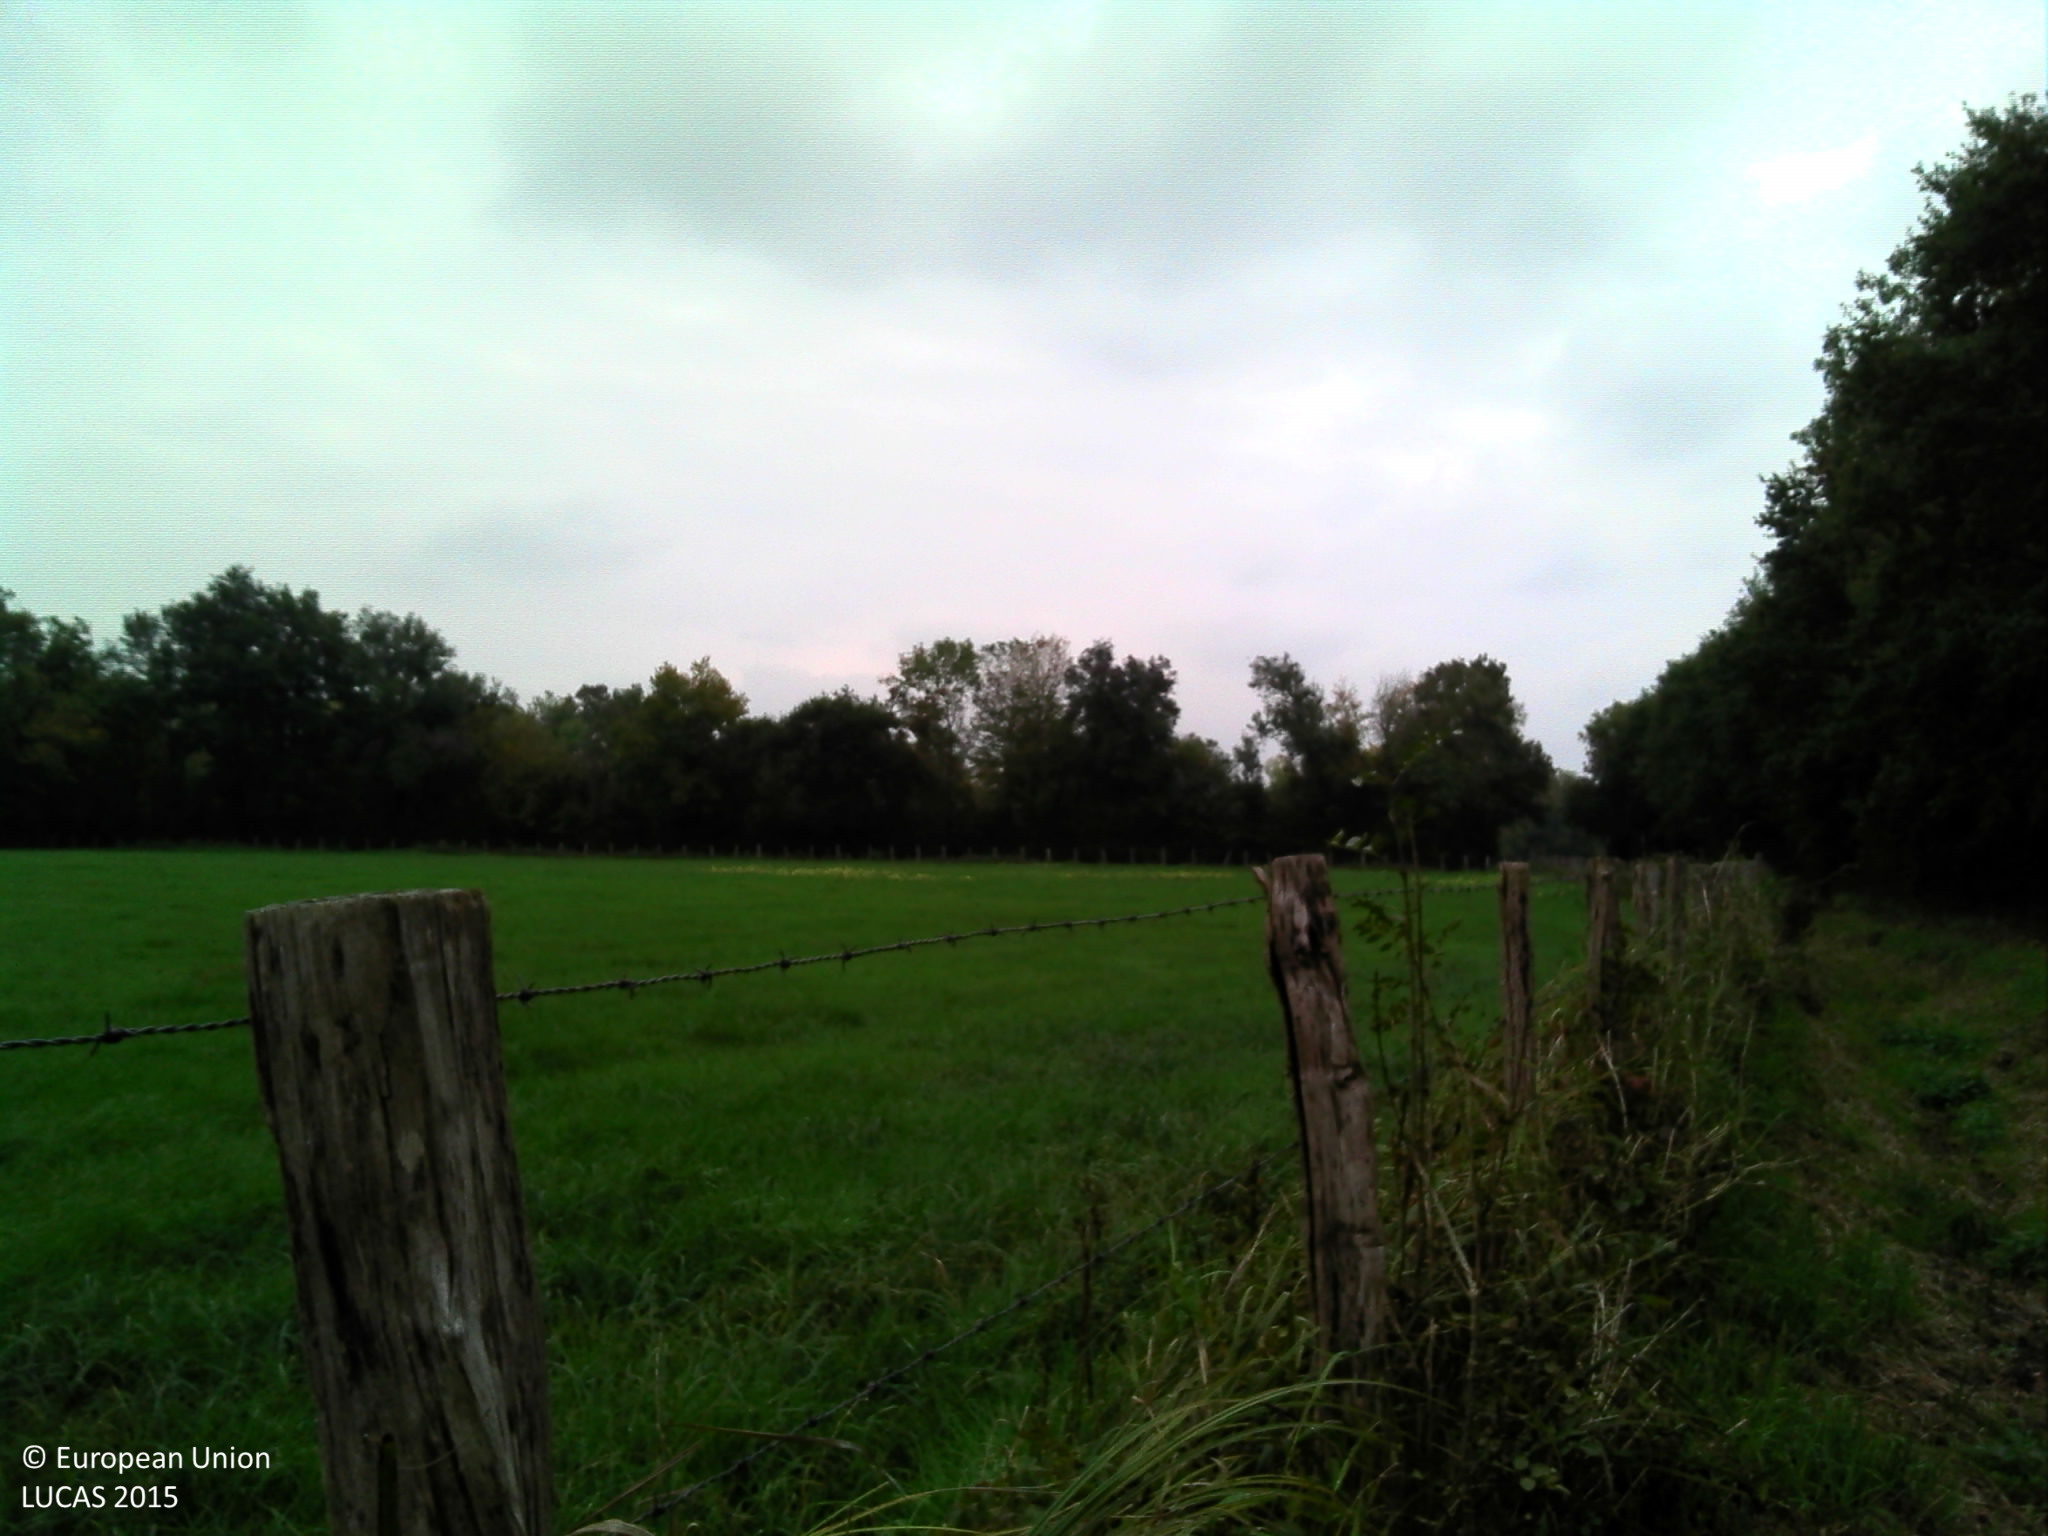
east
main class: Grassland
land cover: Grassland without tree/shrub cover
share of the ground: > 75 %
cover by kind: herbaceous plants 100 %
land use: Agriculture (excluding fallow land and kitchen gardens)
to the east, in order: Grassland without tree/shrub cover; Fences; Ditches and canals; Managed hedges; Grass margins; Tracks; Ditches and canals; Abandoned hedges; Fences; Grassland without tree/shrub cover; Fences; Abandoned hedges; Ditches and canals; Grass margins; Tracks; Grass margins; Ditches and canals; Broadleaved woodland
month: October
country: FR
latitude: 46.2070
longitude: 4.8052
